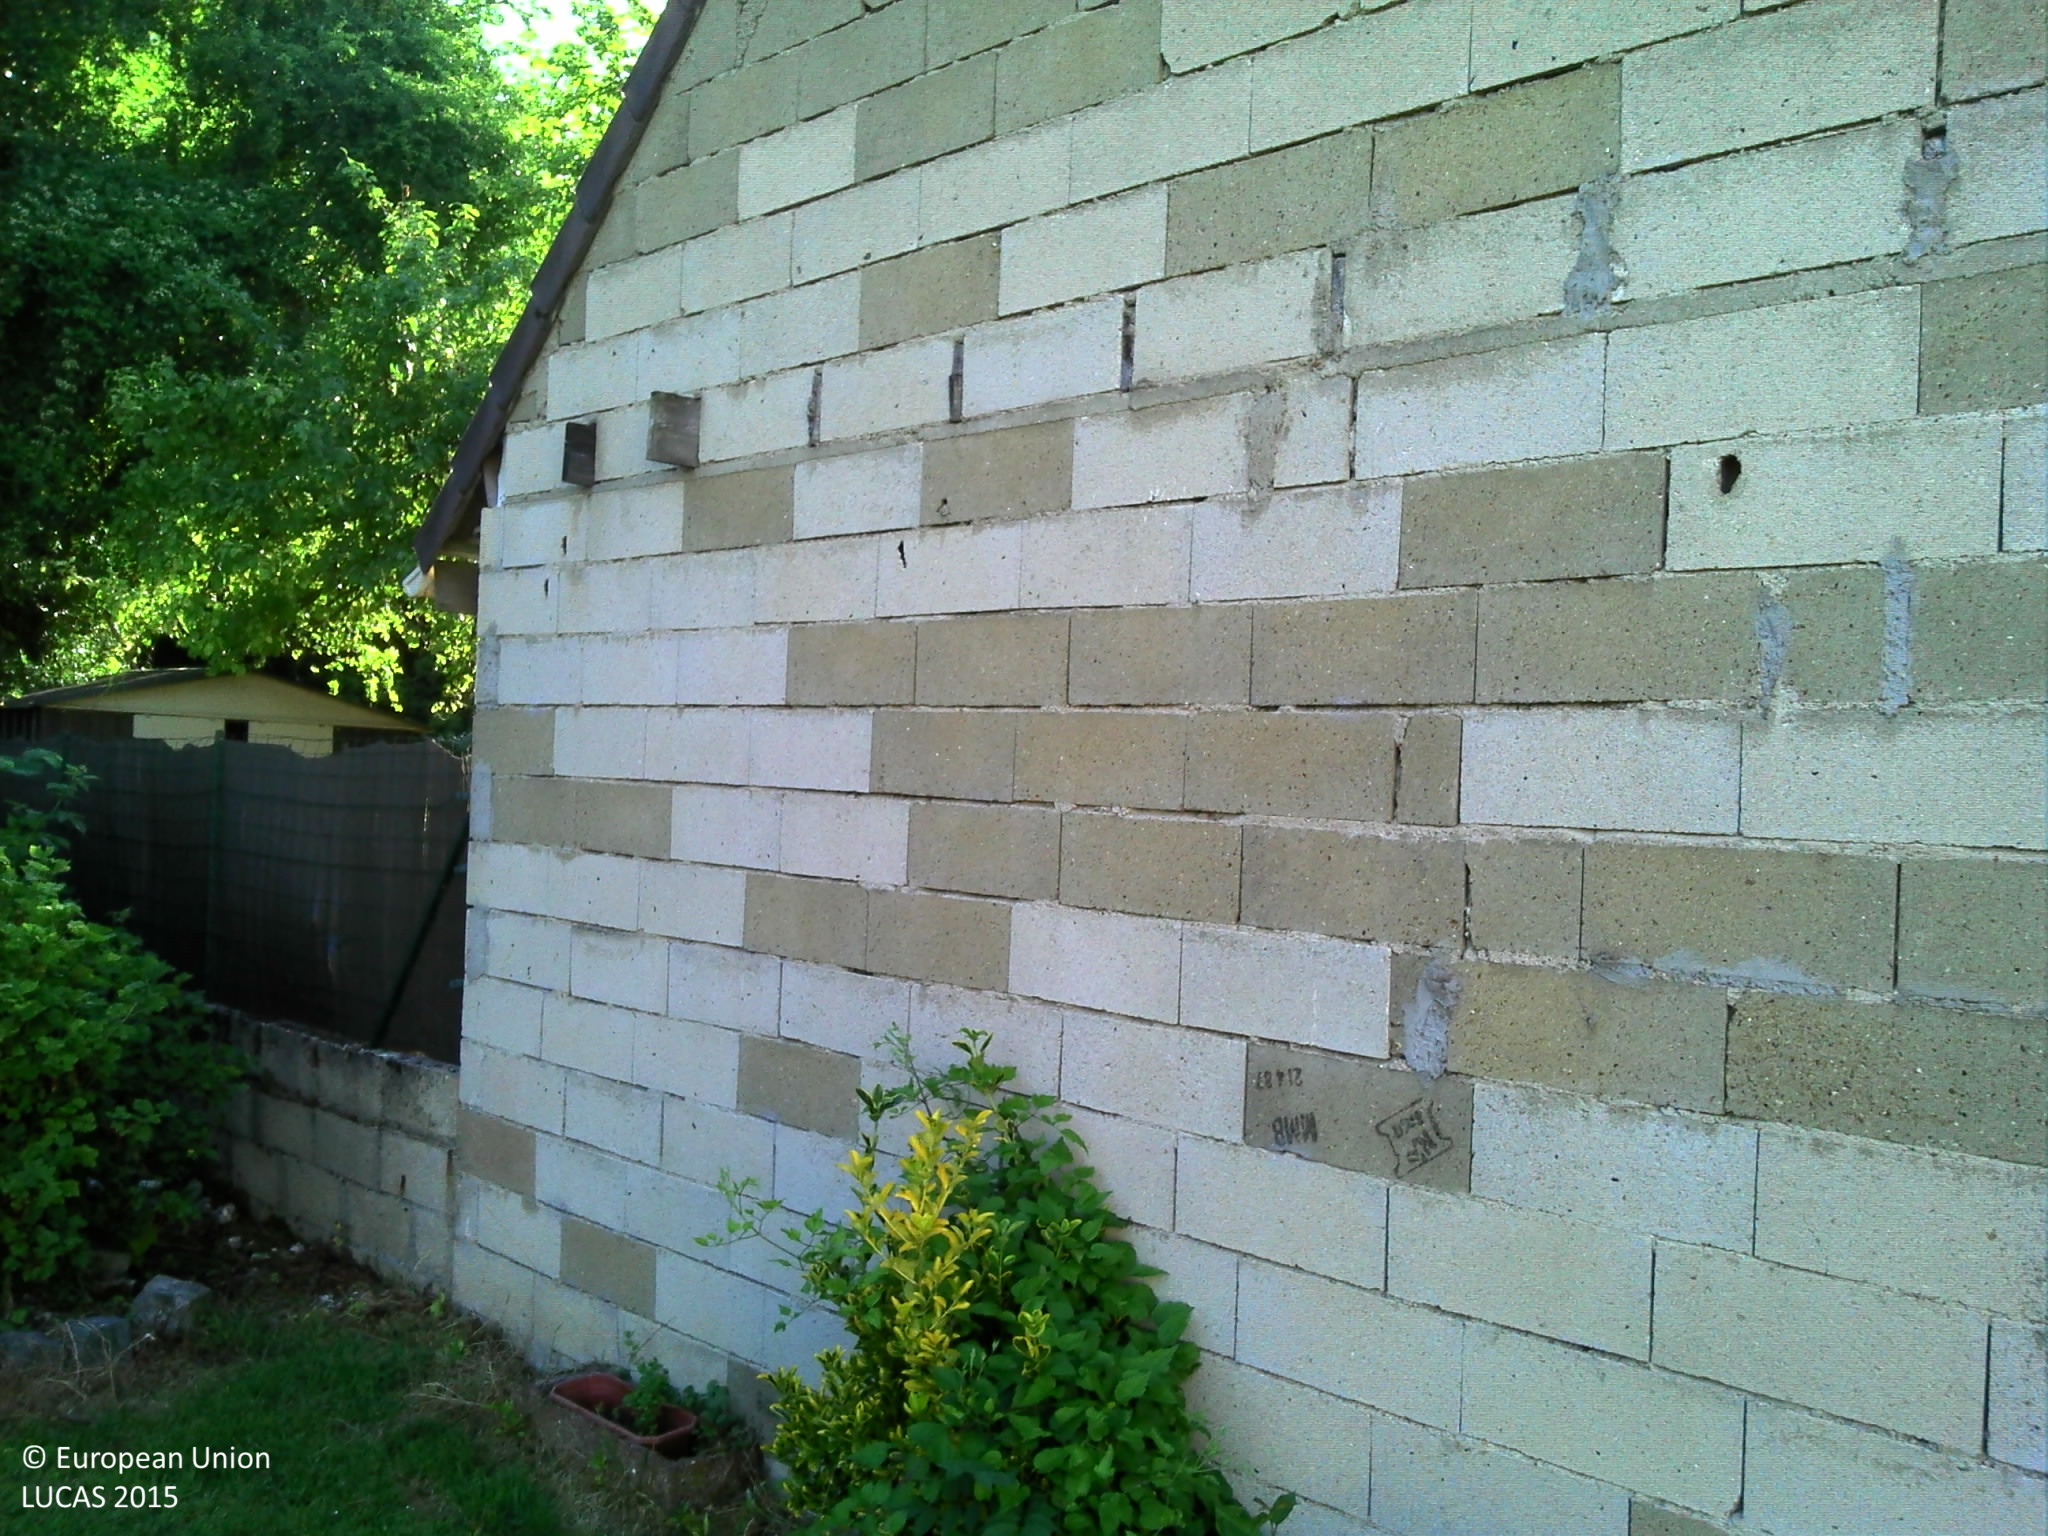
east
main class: Grassland
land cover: Grassland with sparse tree/shrub cover
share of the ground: > 75 %
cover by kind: herbaceous plants 95 %, coniferous forest trees 5 %
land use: Residential
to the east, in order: Grassland with sparse tree/shrub cover; Artificial constructions in urban areas; Grassland without tree/shrub cover; Fences; Lines of trees; Artificial constructions in urban areas; Grassland without tree/shrub cover; Fences; Grassland with sparse tree/shrub cover; Lines of trees; Electric lines; Paved roads, cycling and walking lanes; Grass margins; Ditches and canals; Fences; Managed hedges; Electric lines; Grassland with sparse tree/shrub cover; Managed hedges; Fences; Grassland with sparse tree/shrub cover; Artificial constructions in urban areas; Grassland with sparse tree/shrub cover; Fences; Managed hedges; Grassland with sparse tree/shrub cover; Managed hedges; Fences; Grassland with sparse tree/shrub cover; Artificial constructions in urban areas; Fences; Tracks; Fences
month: June
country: FR
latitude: 49.4560
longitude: 2.3305
